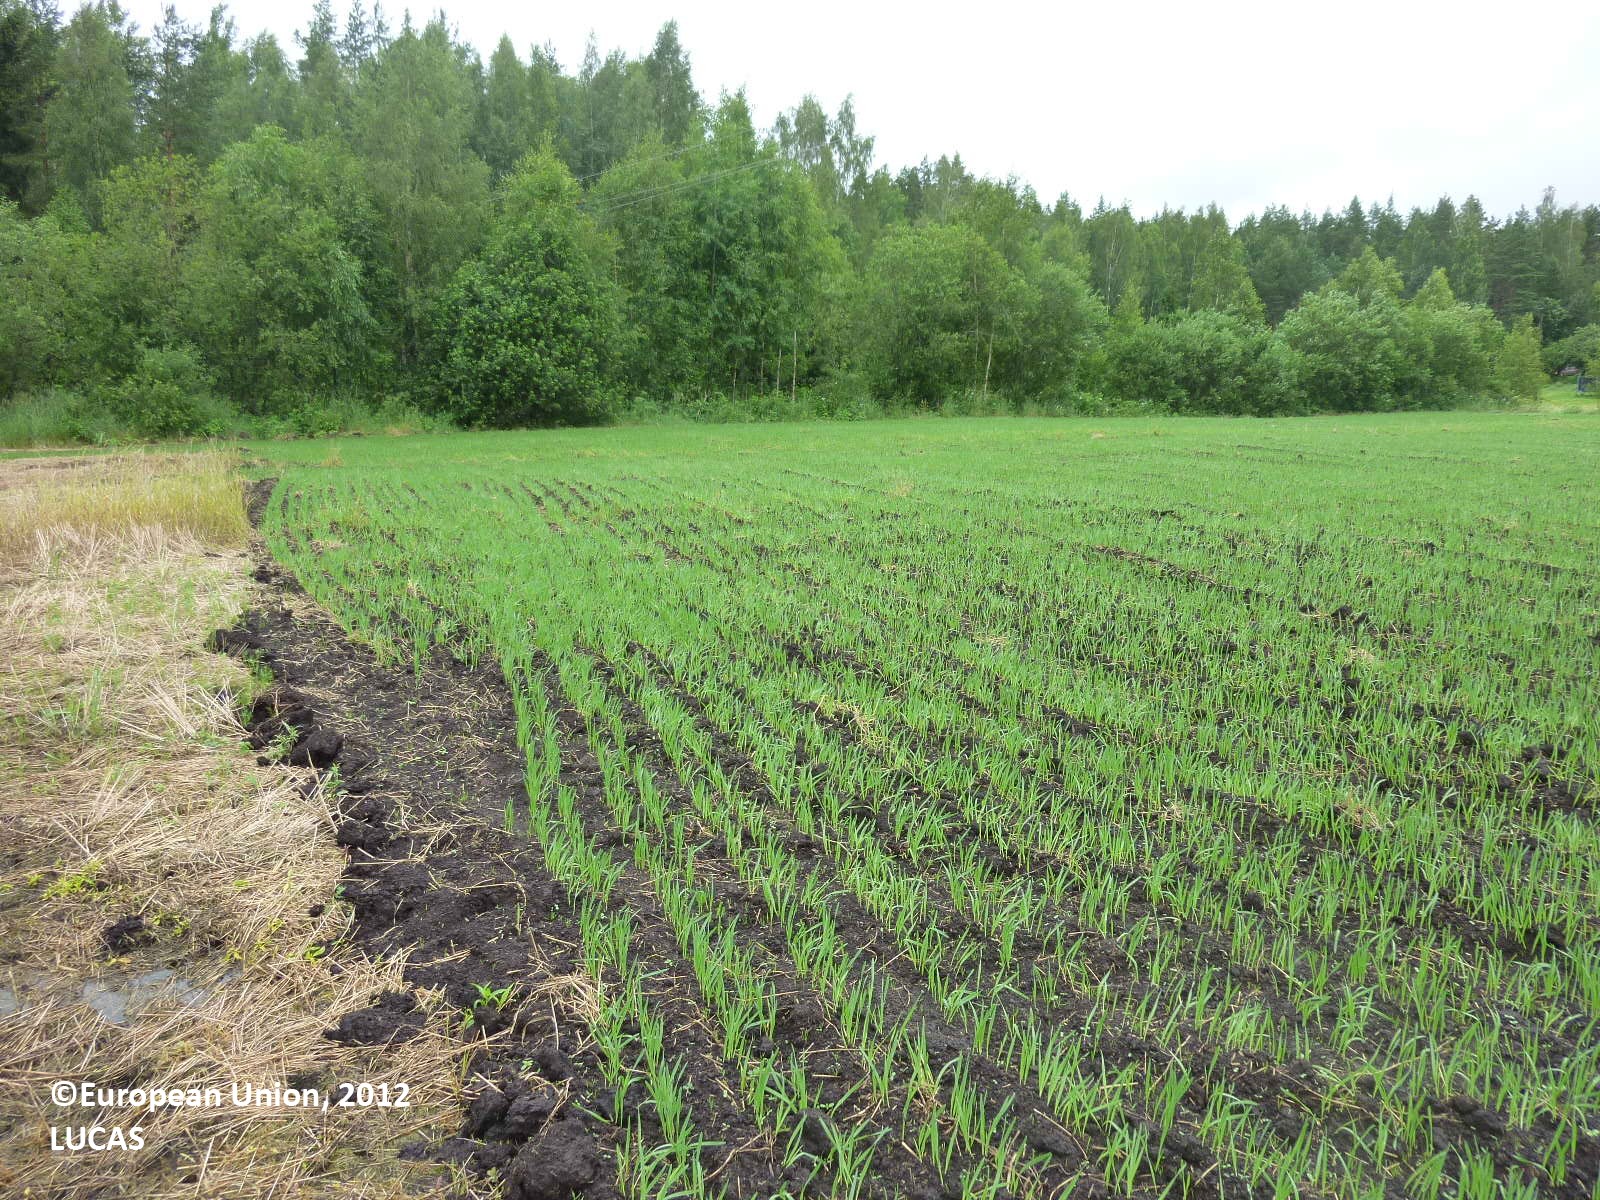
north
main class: Cropland
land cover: Oats
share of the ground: > 75 %
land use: Agriculture (excluding fallow land and kitchen gardens)
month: July
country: FI
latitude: 61.4651
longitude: 22.7340
